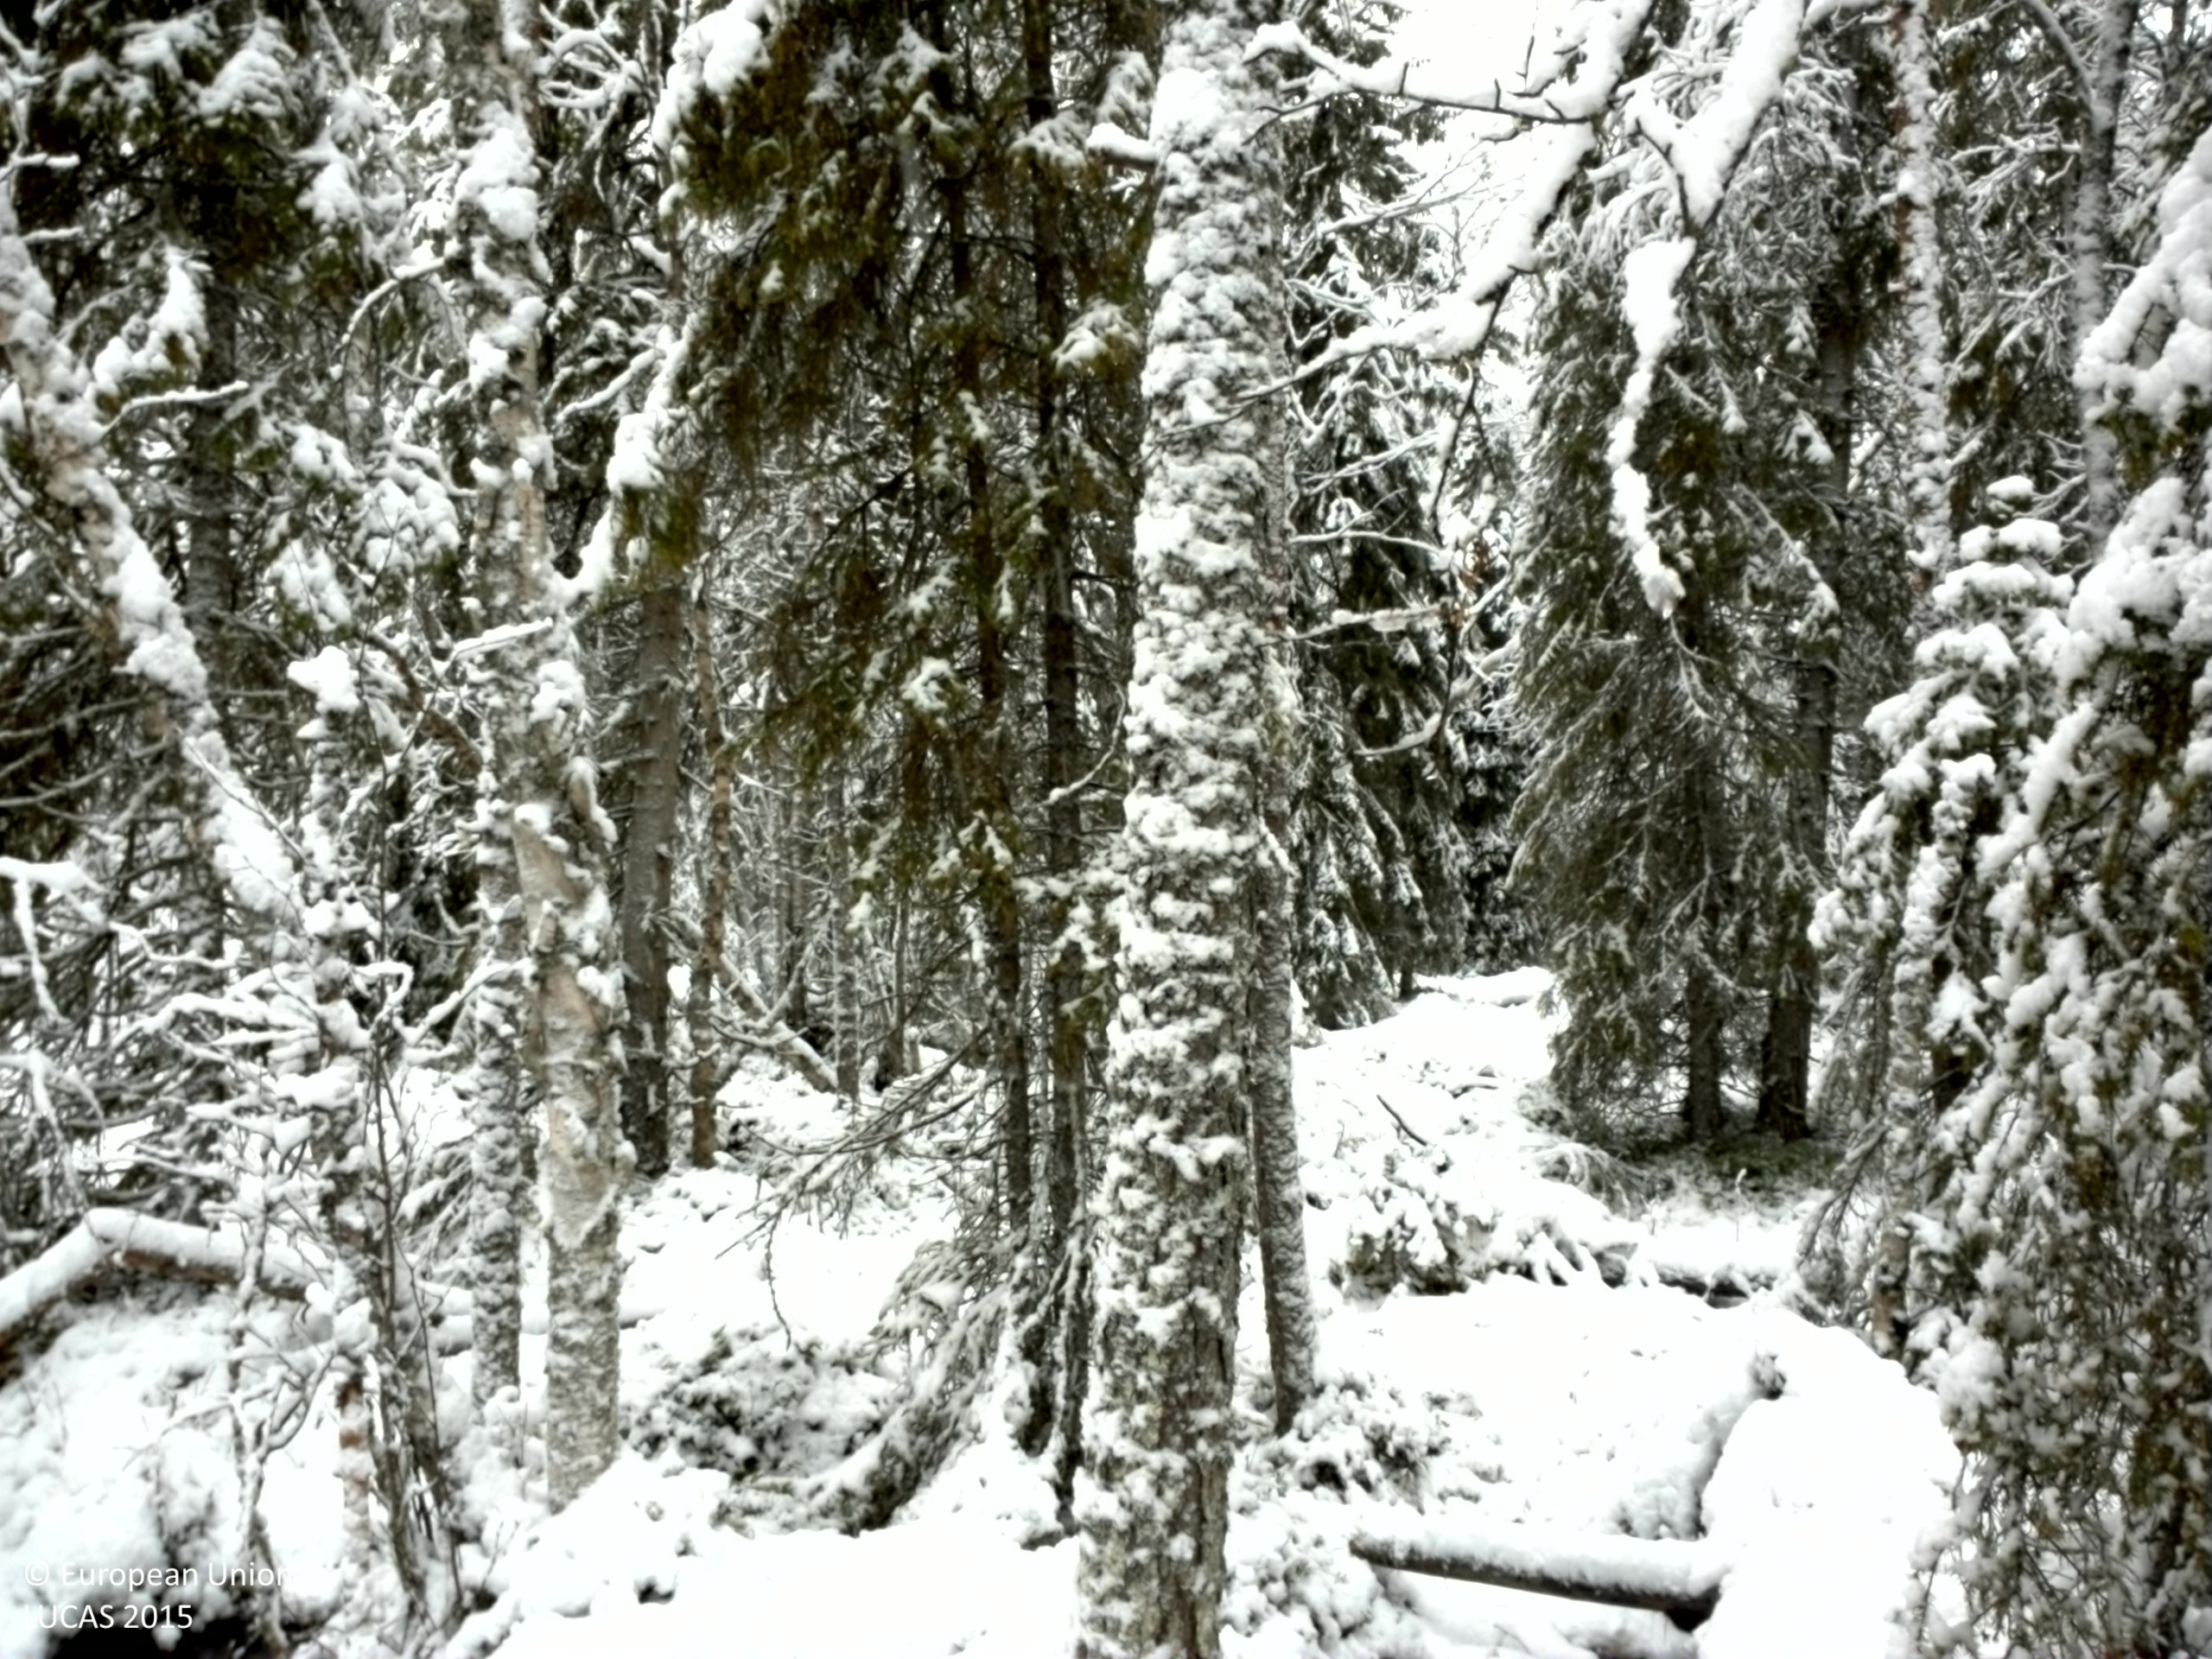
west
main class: Woodland
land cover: Other mixed woodland
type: boreal forest
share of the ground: 50 - 75 %
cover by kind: coniferous forest trees 45 %, shrubs 25 %, broadleaved forest trees 15 %, lichens and mosses 10 %, herbaceous plants 5 %
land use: Forestry
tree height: > 5 m
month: November
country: SE
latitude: 63.7595
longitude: 15.5081
